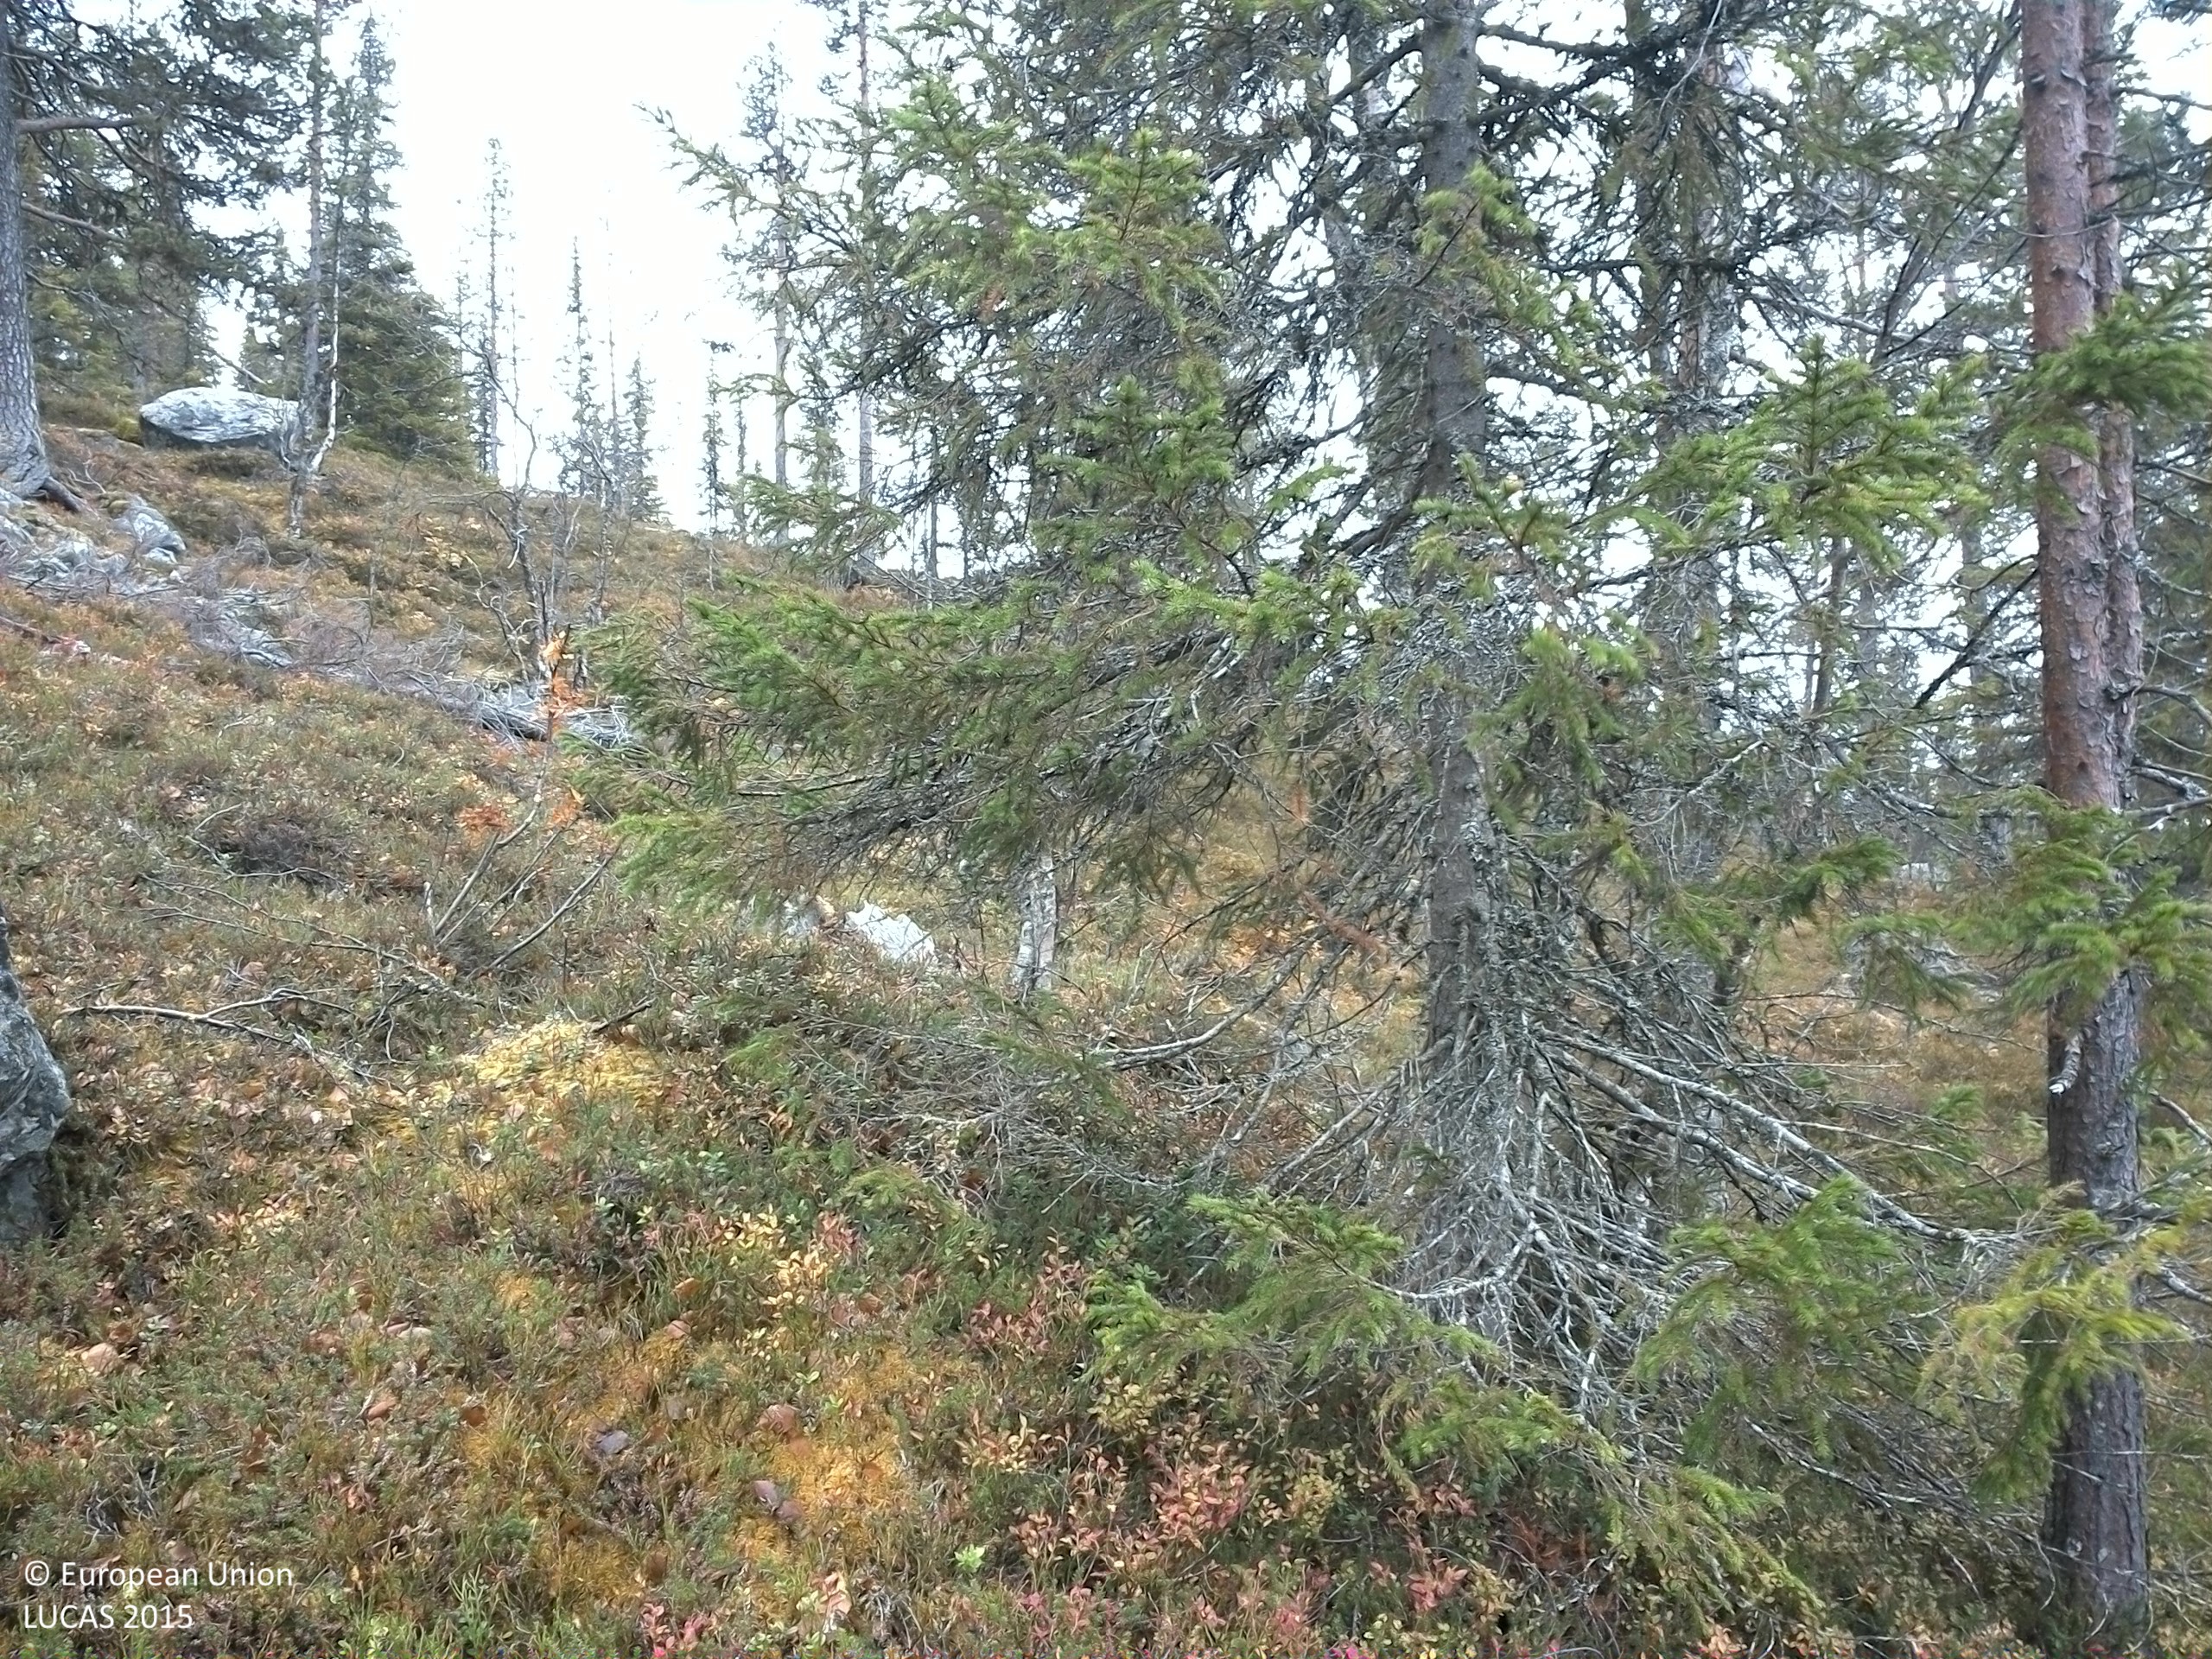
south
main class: Woodland
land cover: Other mixed woodland
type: boreal forest
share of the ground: 25 - 50 %
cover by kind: shrubs 30 %, coniferous forest trees 25 %, consolidated bare surface 20 %, lichens and mosses 15 %, broadleaved forest trees 10 %
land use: Forestry
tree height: > 5 m
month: October
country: SE
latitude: 64.4194
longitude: 15.2644
